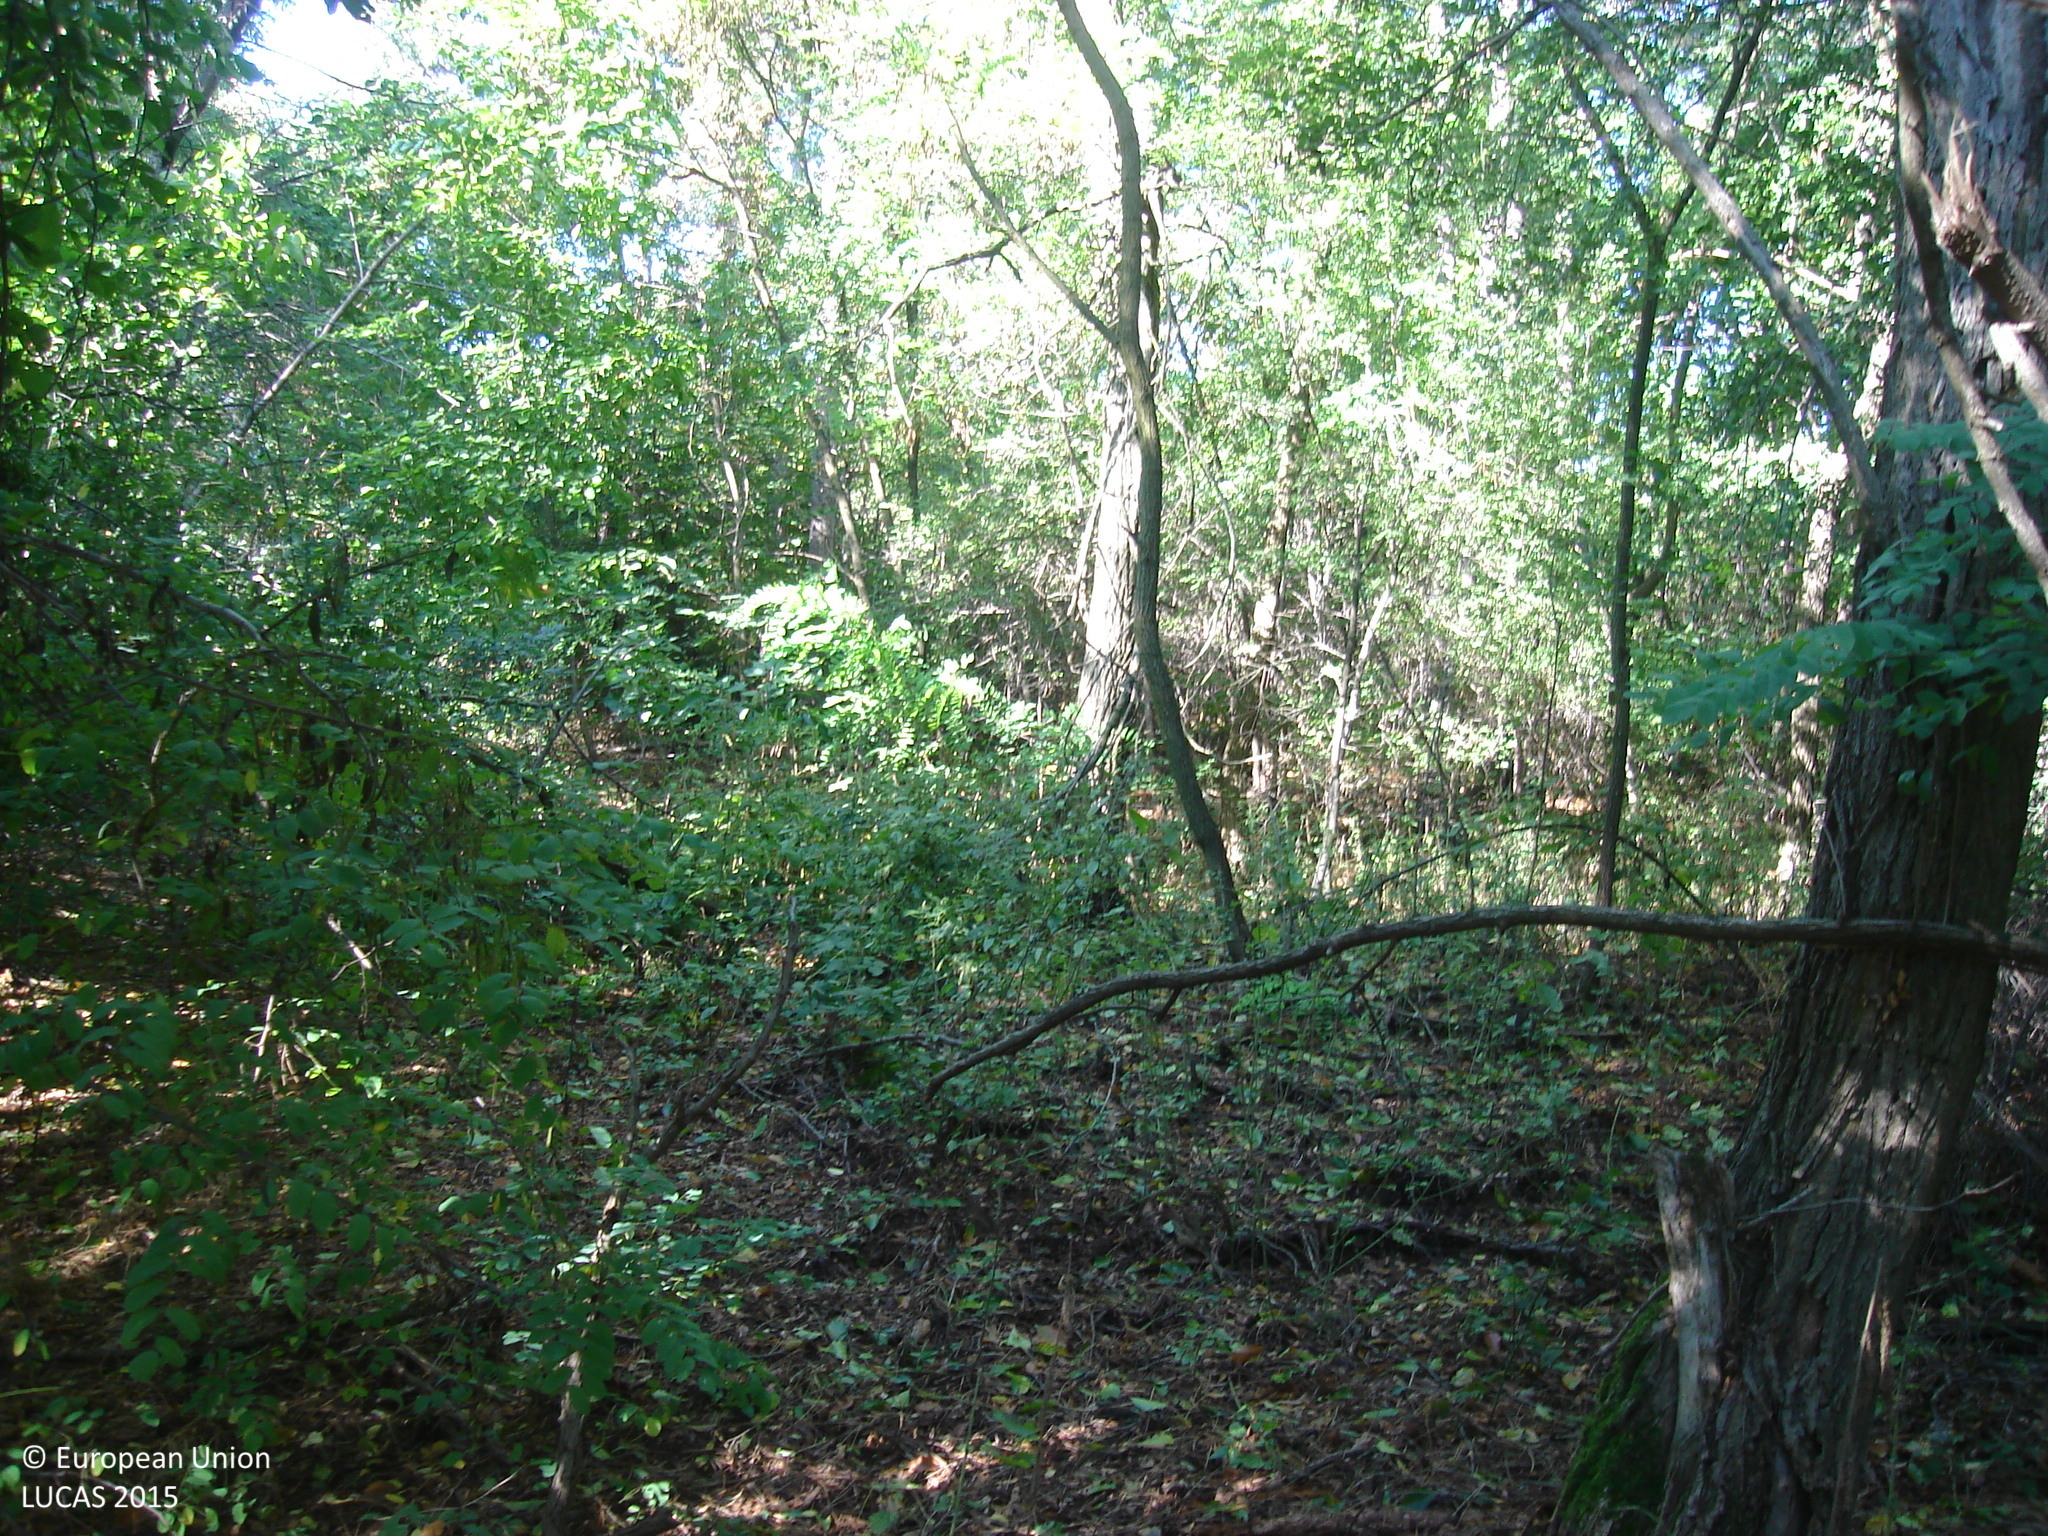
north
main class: Woodland
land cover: Broadleaved woodland
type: mesophytic deciduous forest
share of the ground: > 75 %
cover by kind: broadleaved forest trees 80 %, consolidated bare surface 15 %, shrubs 5 %
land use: Forestry
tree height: > 5 m
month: September
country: BG
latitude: 42.3648
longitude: 23.9186
